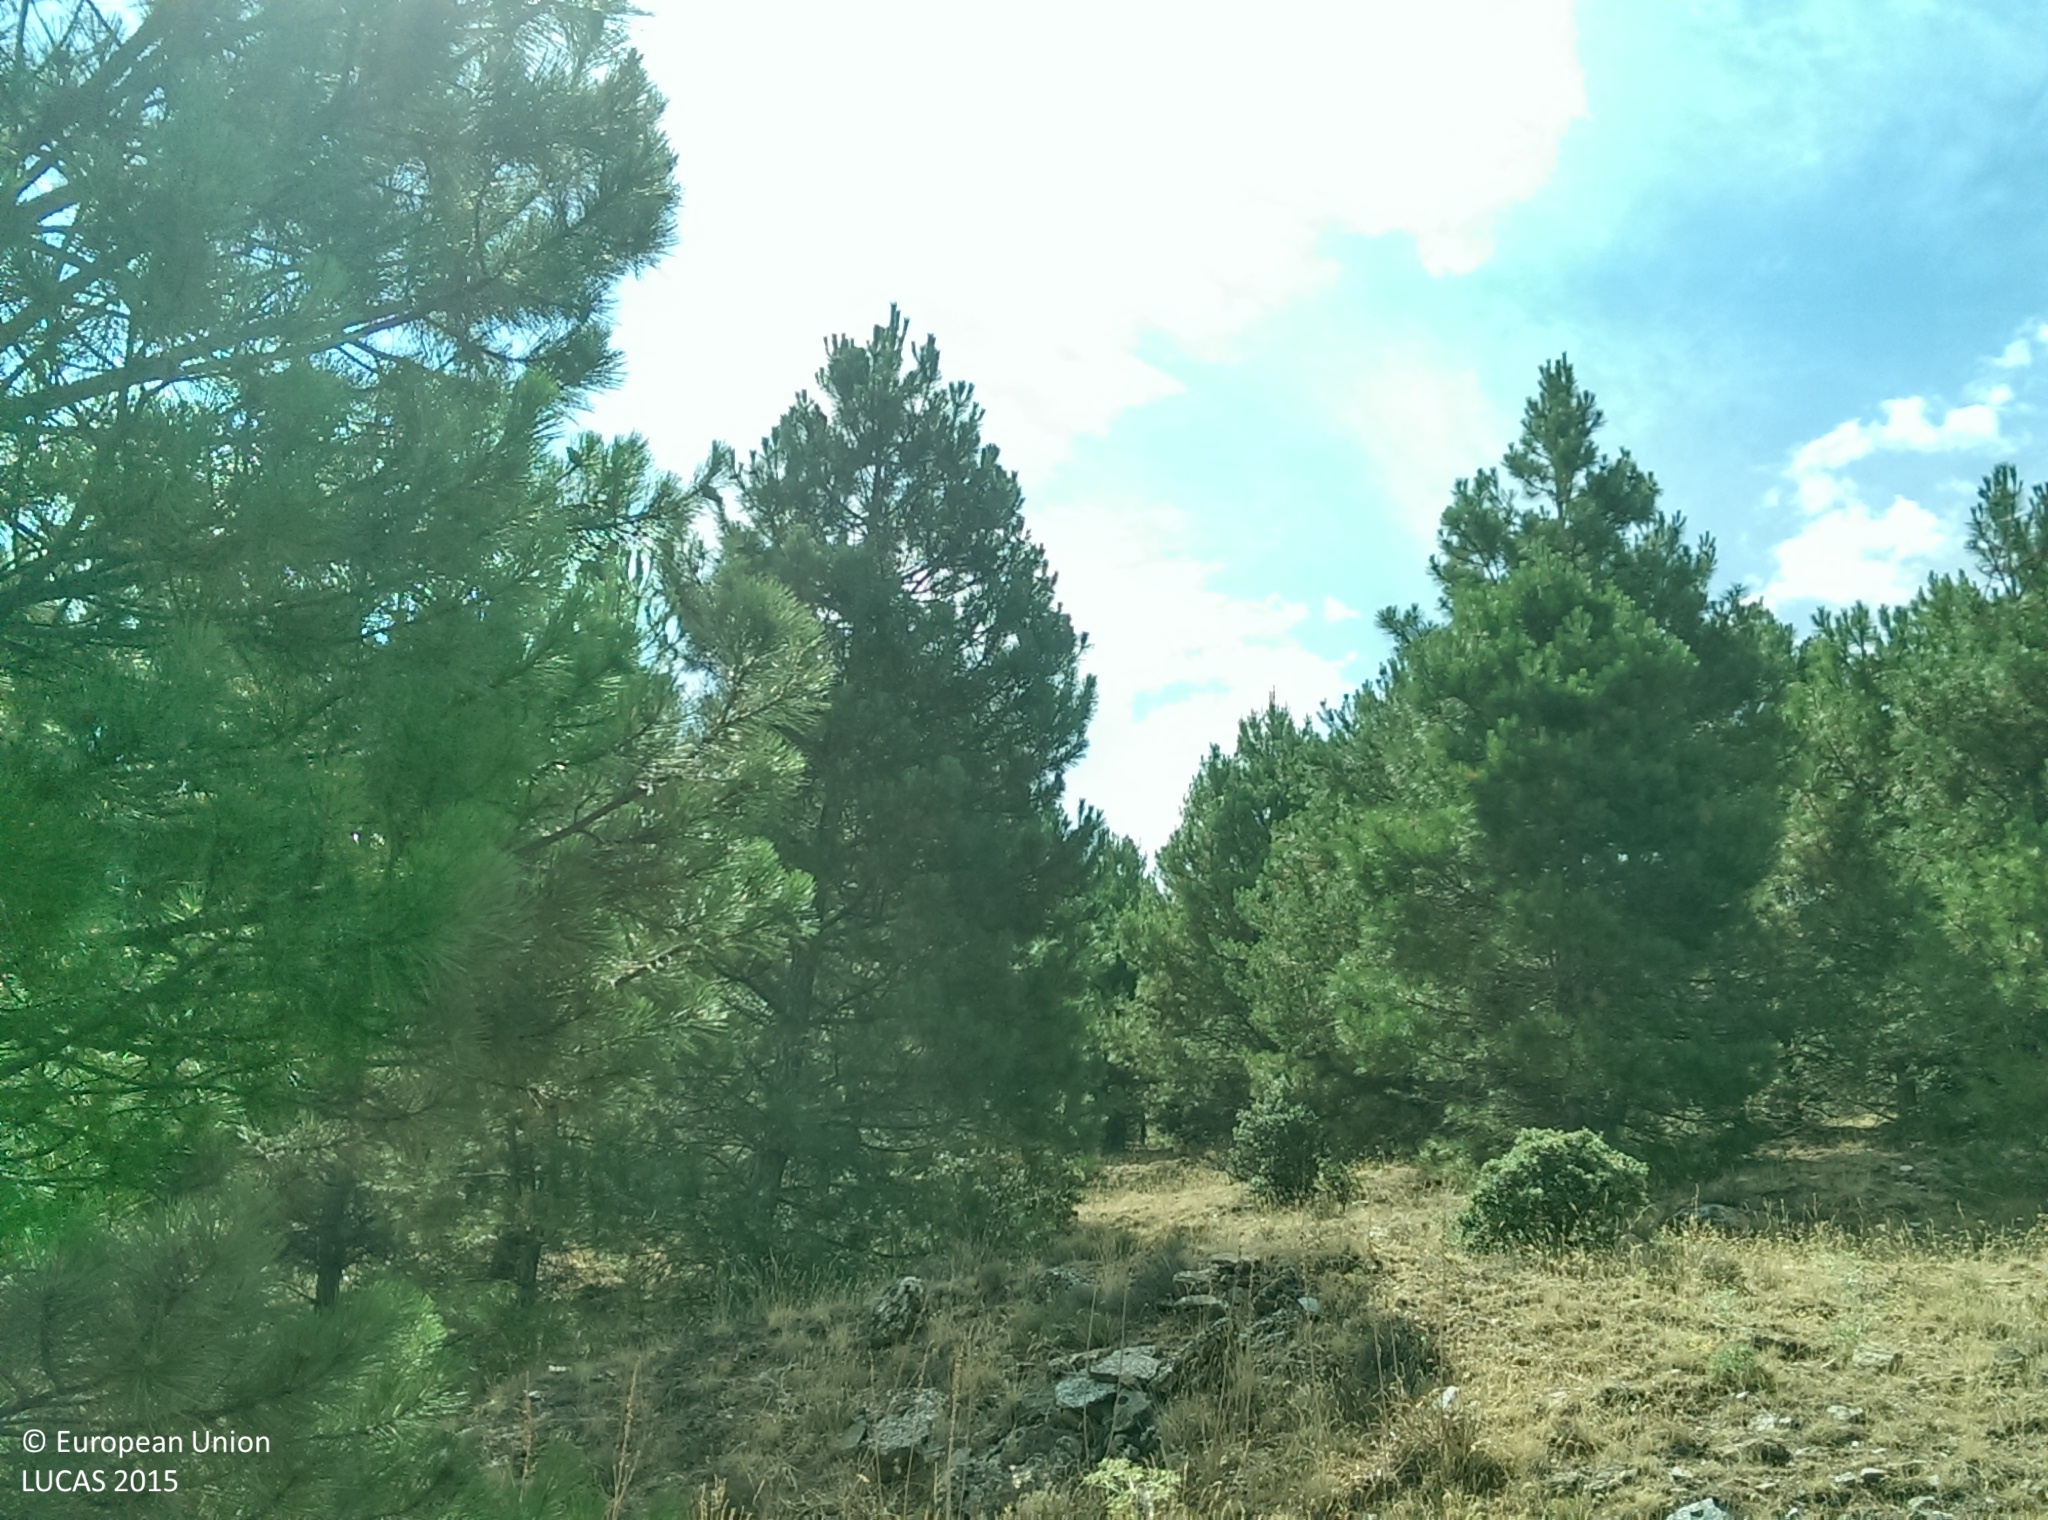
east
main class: Woodland
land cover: Pine dominated coniferous woodland
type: coniferous forest of the mediterranean region
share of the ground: 50 - 75 %
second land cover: Grassland without tree/shrub cover
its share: 25 - 50 %
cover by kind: coniferous forest trees 50 %, herbaceous plants 30 %, shrubs 10 %, unconsolidated bare surface 10 %
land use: Forestry
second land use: Agriculture (excluding fallow land and kitchen gardens)
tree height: > 5 m
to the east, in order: Pine dominated coniferous woodland; Grassland without tree/shrub cover; Other structural elements; Broadleaved woodland
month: July
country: ES
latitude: 37.3016
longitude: -2.9255
